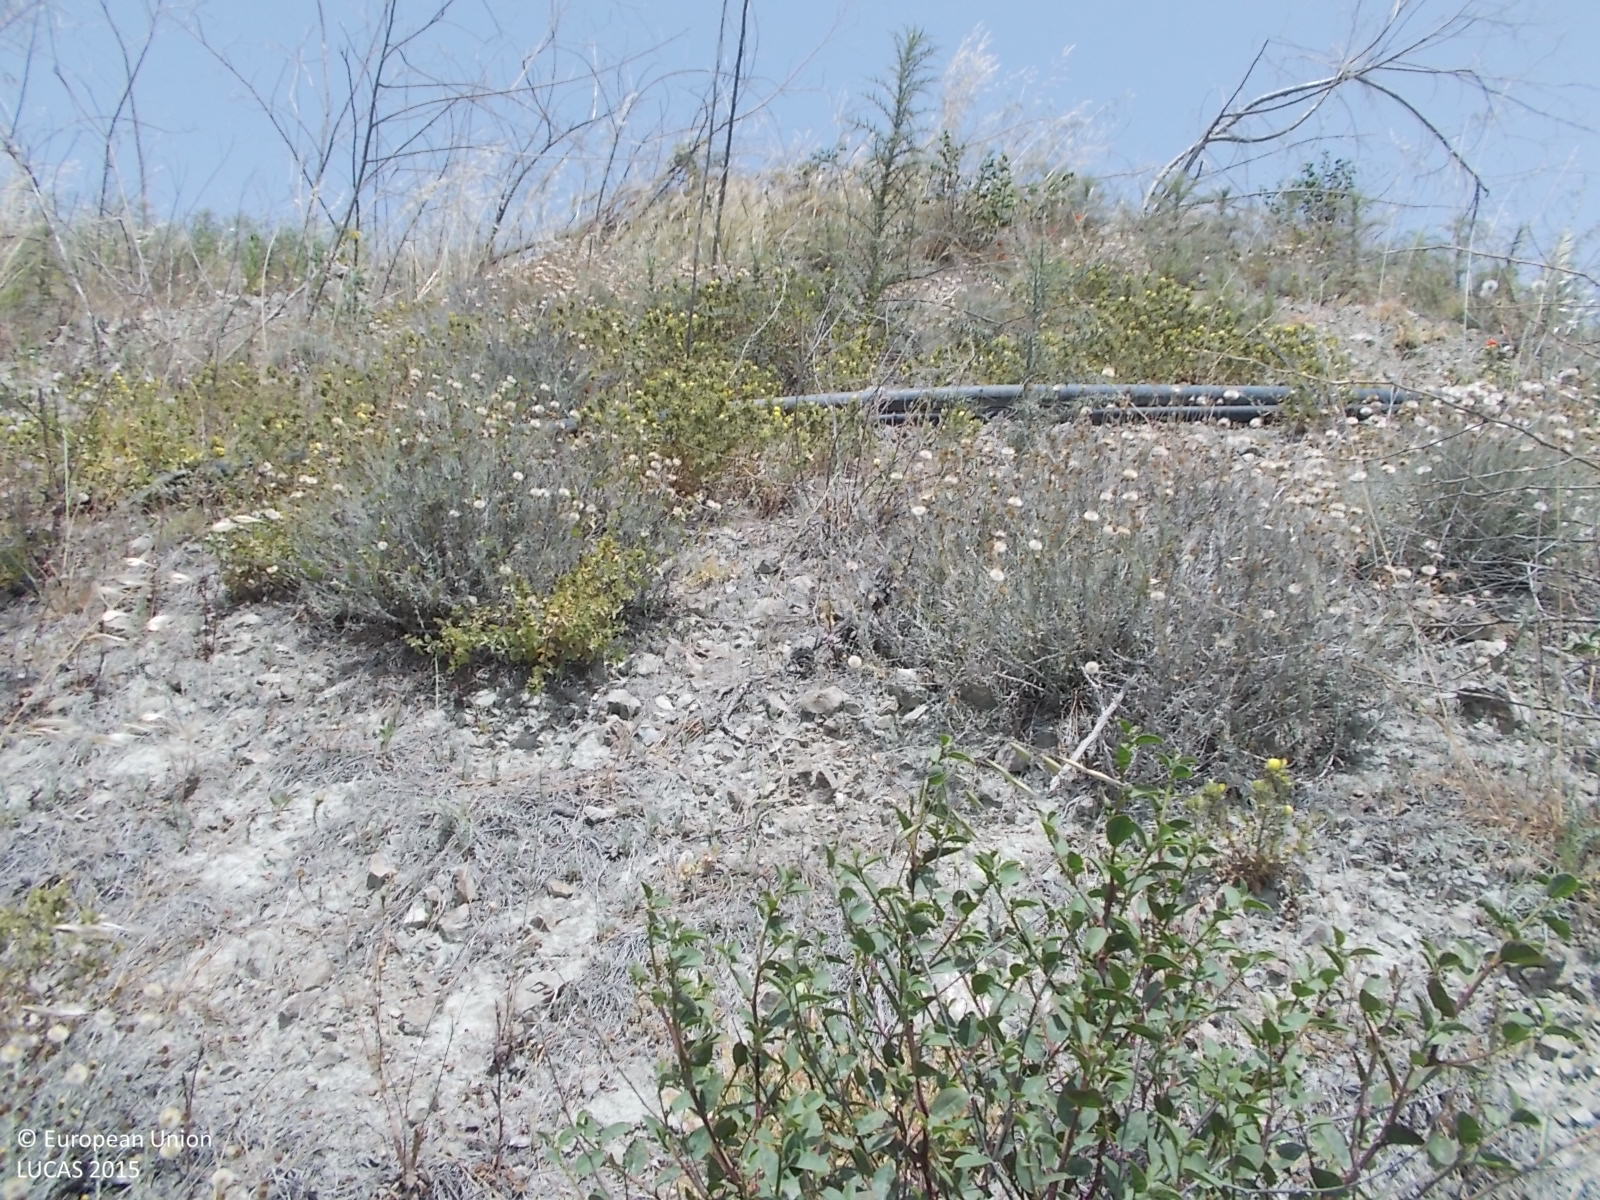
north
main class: Shrubland
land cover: Shrubland with sparse tree cover
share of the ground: 50 - 75 %
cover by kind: unconsolidated bare surface 45 %, shrubs 40 %, herbaceous plants 10 %, coniferous forest trees 5 %
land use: Mining and quarrying
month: April
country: CY
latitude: 34.7750
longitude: 33.2198
